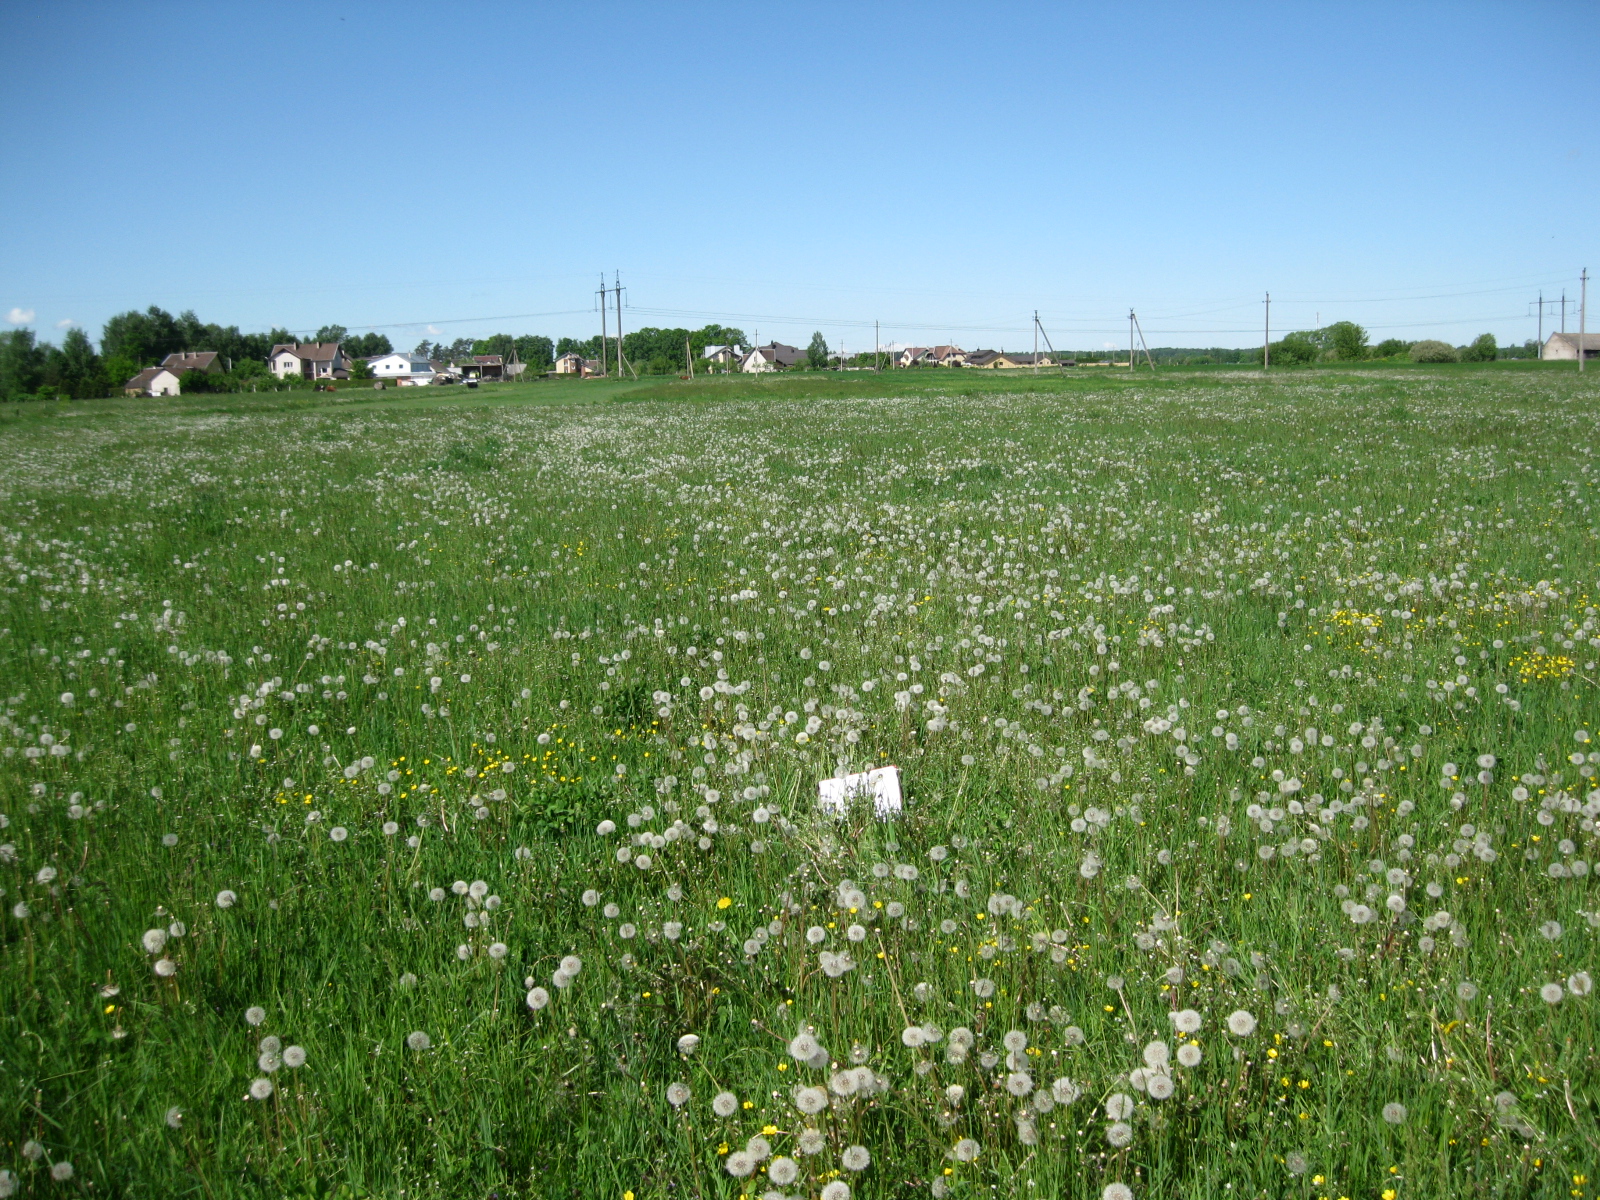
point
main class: Grassland
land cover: Grassland without tree/shrub cover
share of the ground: > 75 %
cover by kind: herbaceous plants 100 %
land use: Agriculture (excluding fallow land and kitchen gardens)
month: May
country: LT
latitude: 55.7833
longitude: 24.3020
